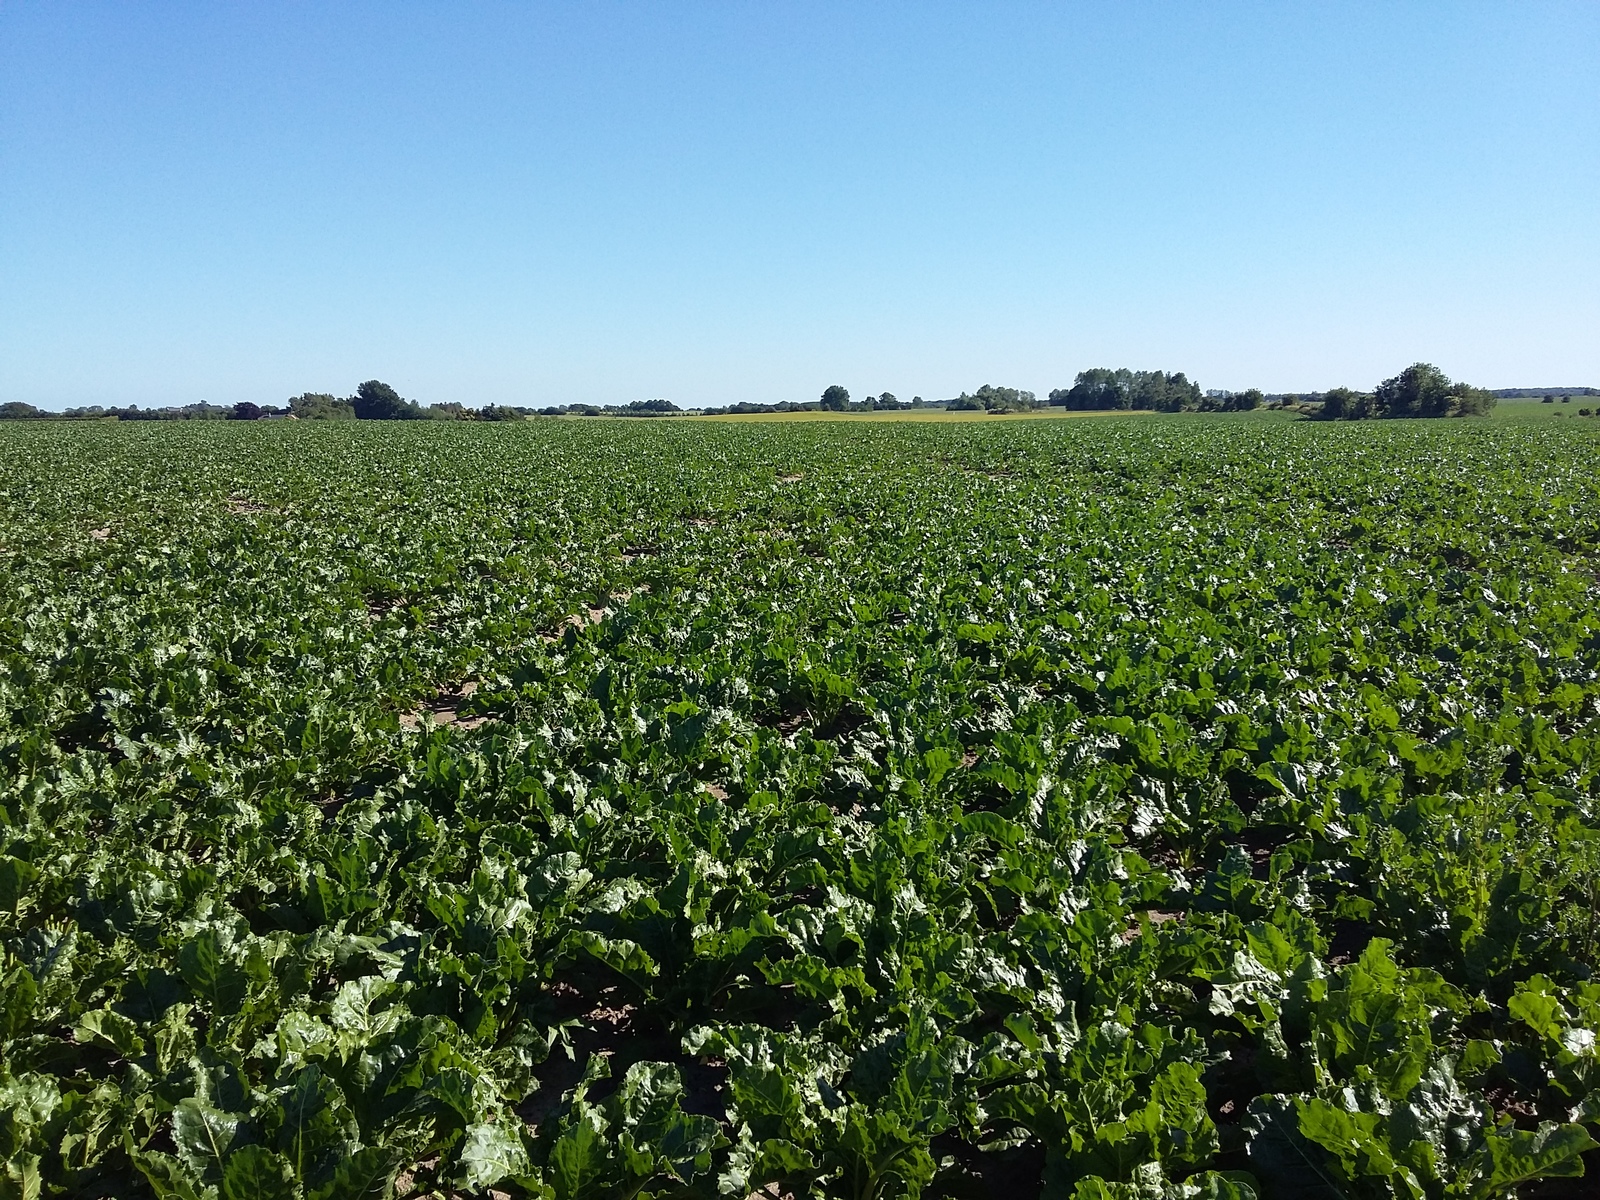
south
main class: Cropland
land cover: Sugar beet
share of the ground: > 75 %
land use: Agriculture (excluding fallow land and kitchen gardens)
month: July
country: DK
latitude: 54.9636
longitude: 12.2321
